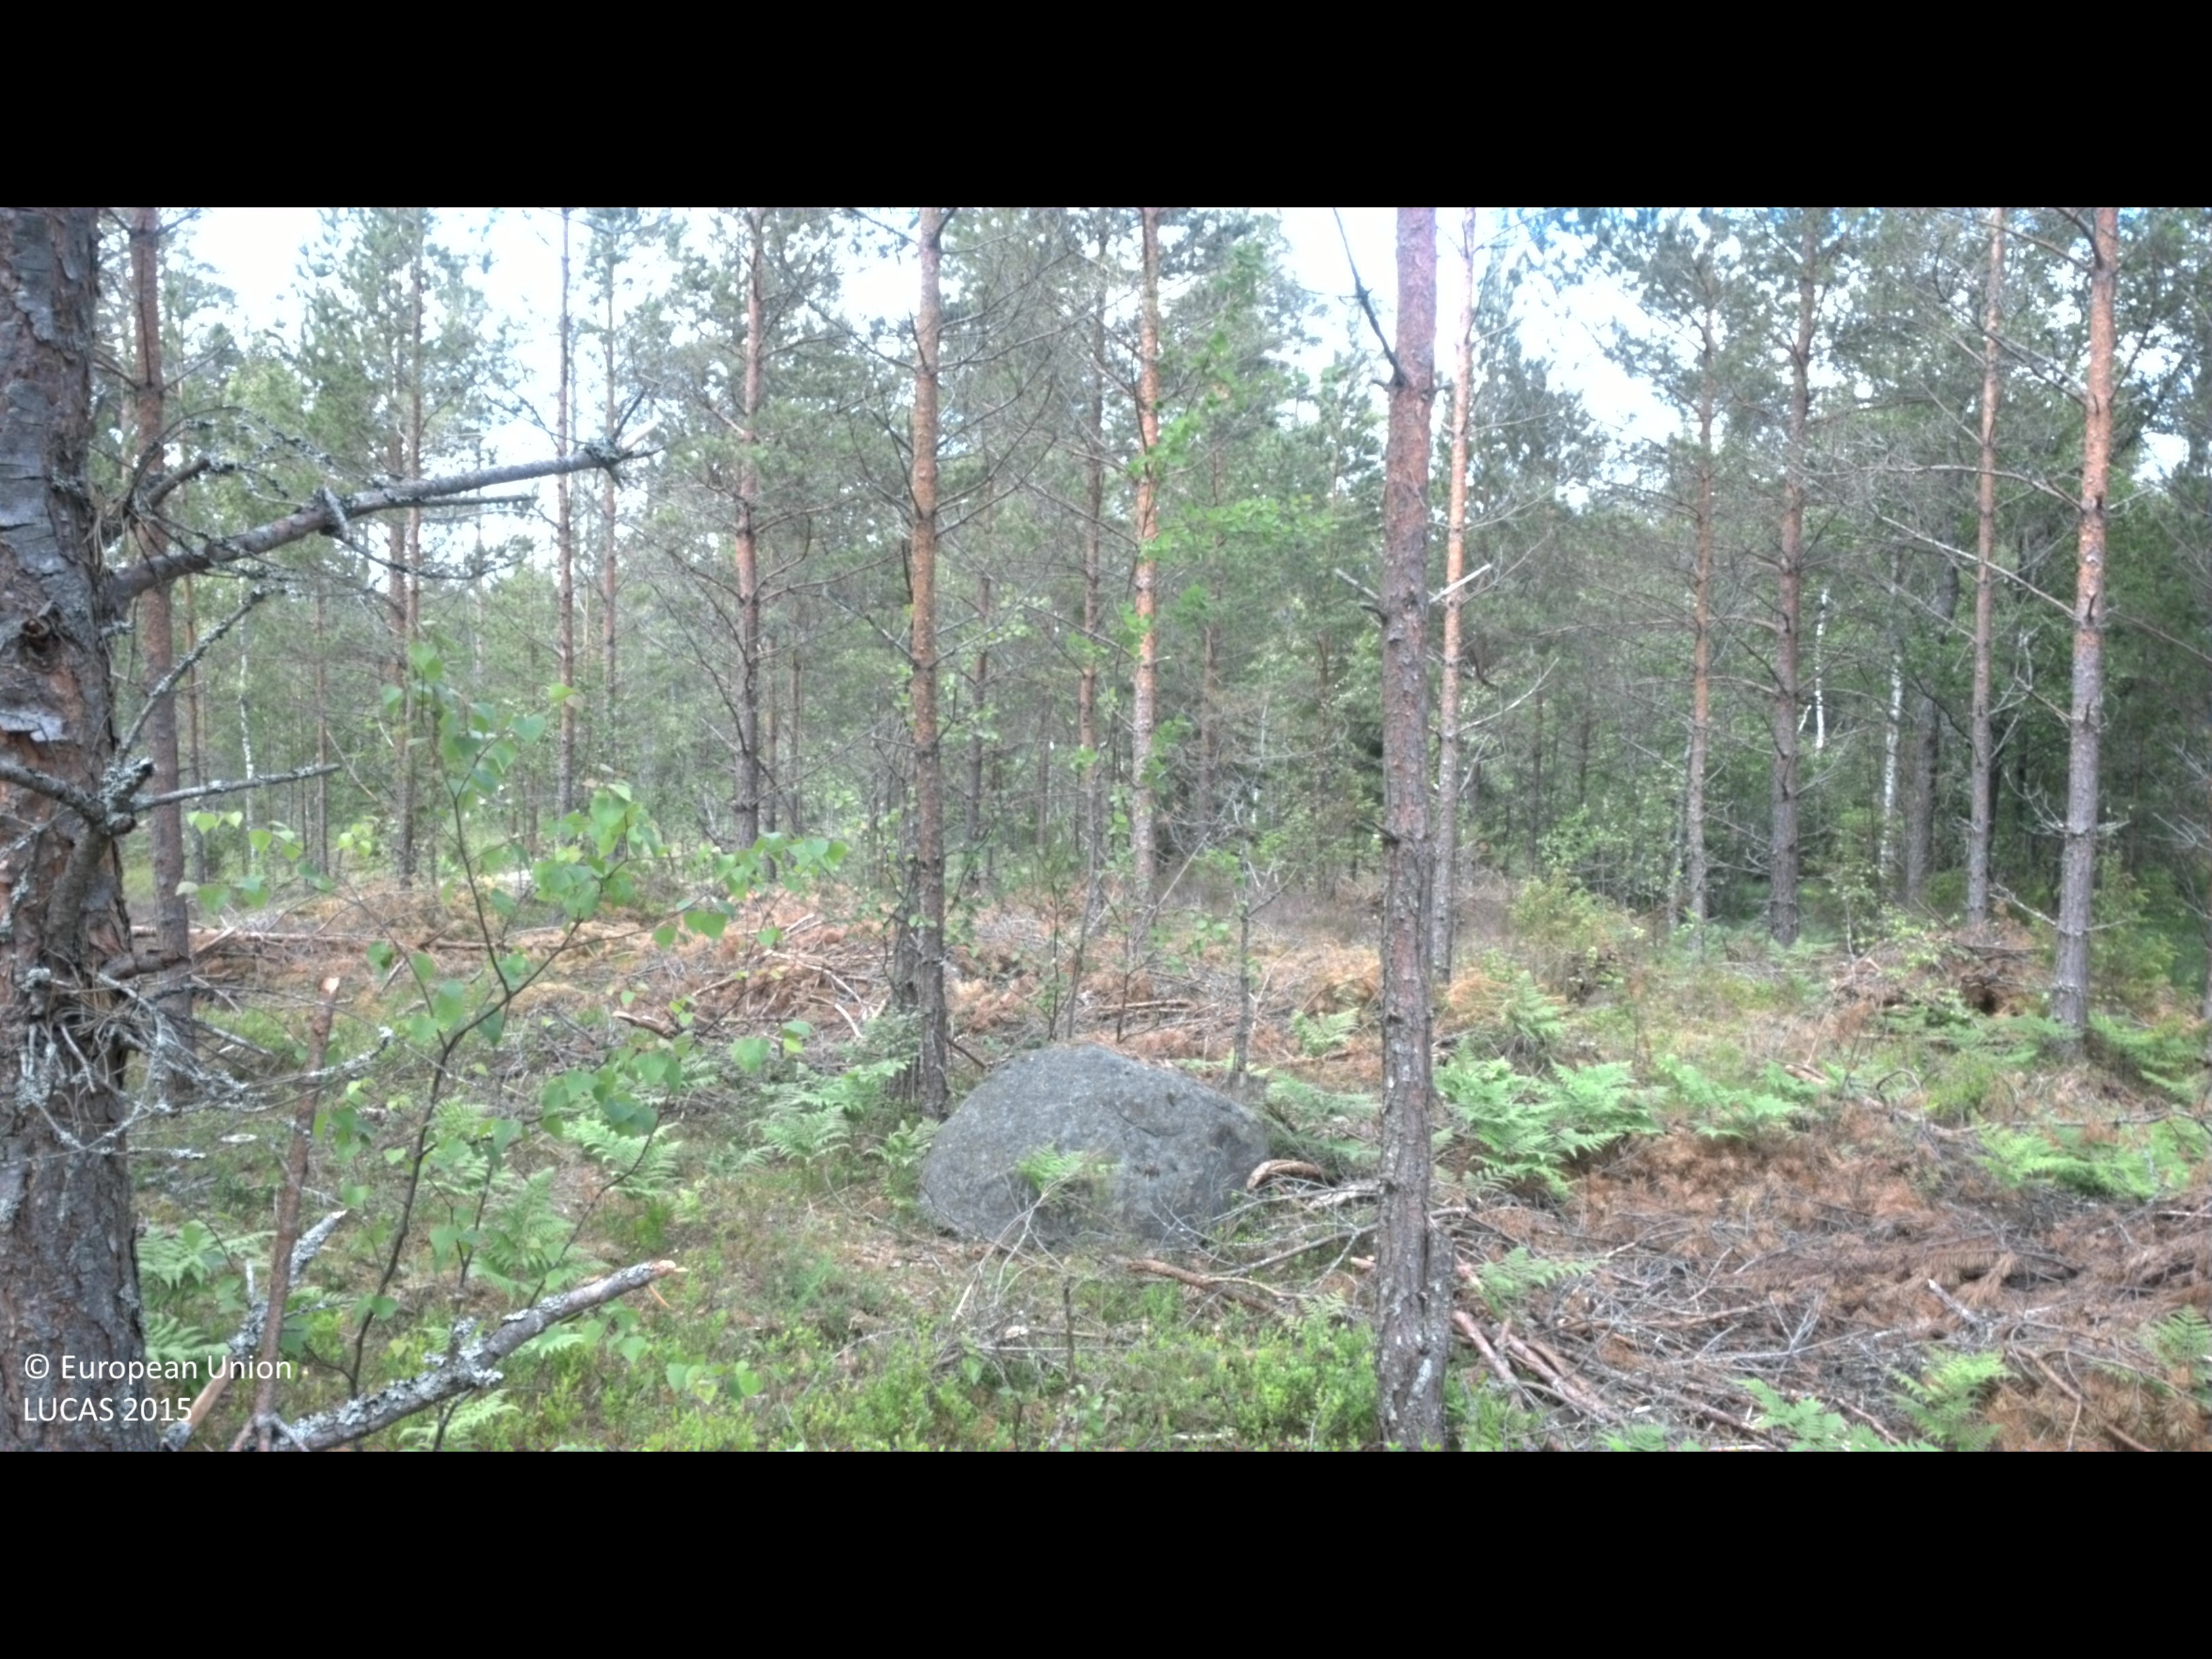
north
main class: Woodland
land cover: Pine dominated coniferous woodland
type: boreal forest
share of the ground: 50 - 75 %
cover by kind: coniferous forest trees 60 %, shrubs 20 %, herbaceous plants 10 %, broadleaved forest trees 5 %, unconsolidated bare surface 5 %
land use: Forestry
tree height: > 5 m
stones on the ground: < 10 %
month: June
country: SE
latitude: 57.7000
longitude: 16.5257
